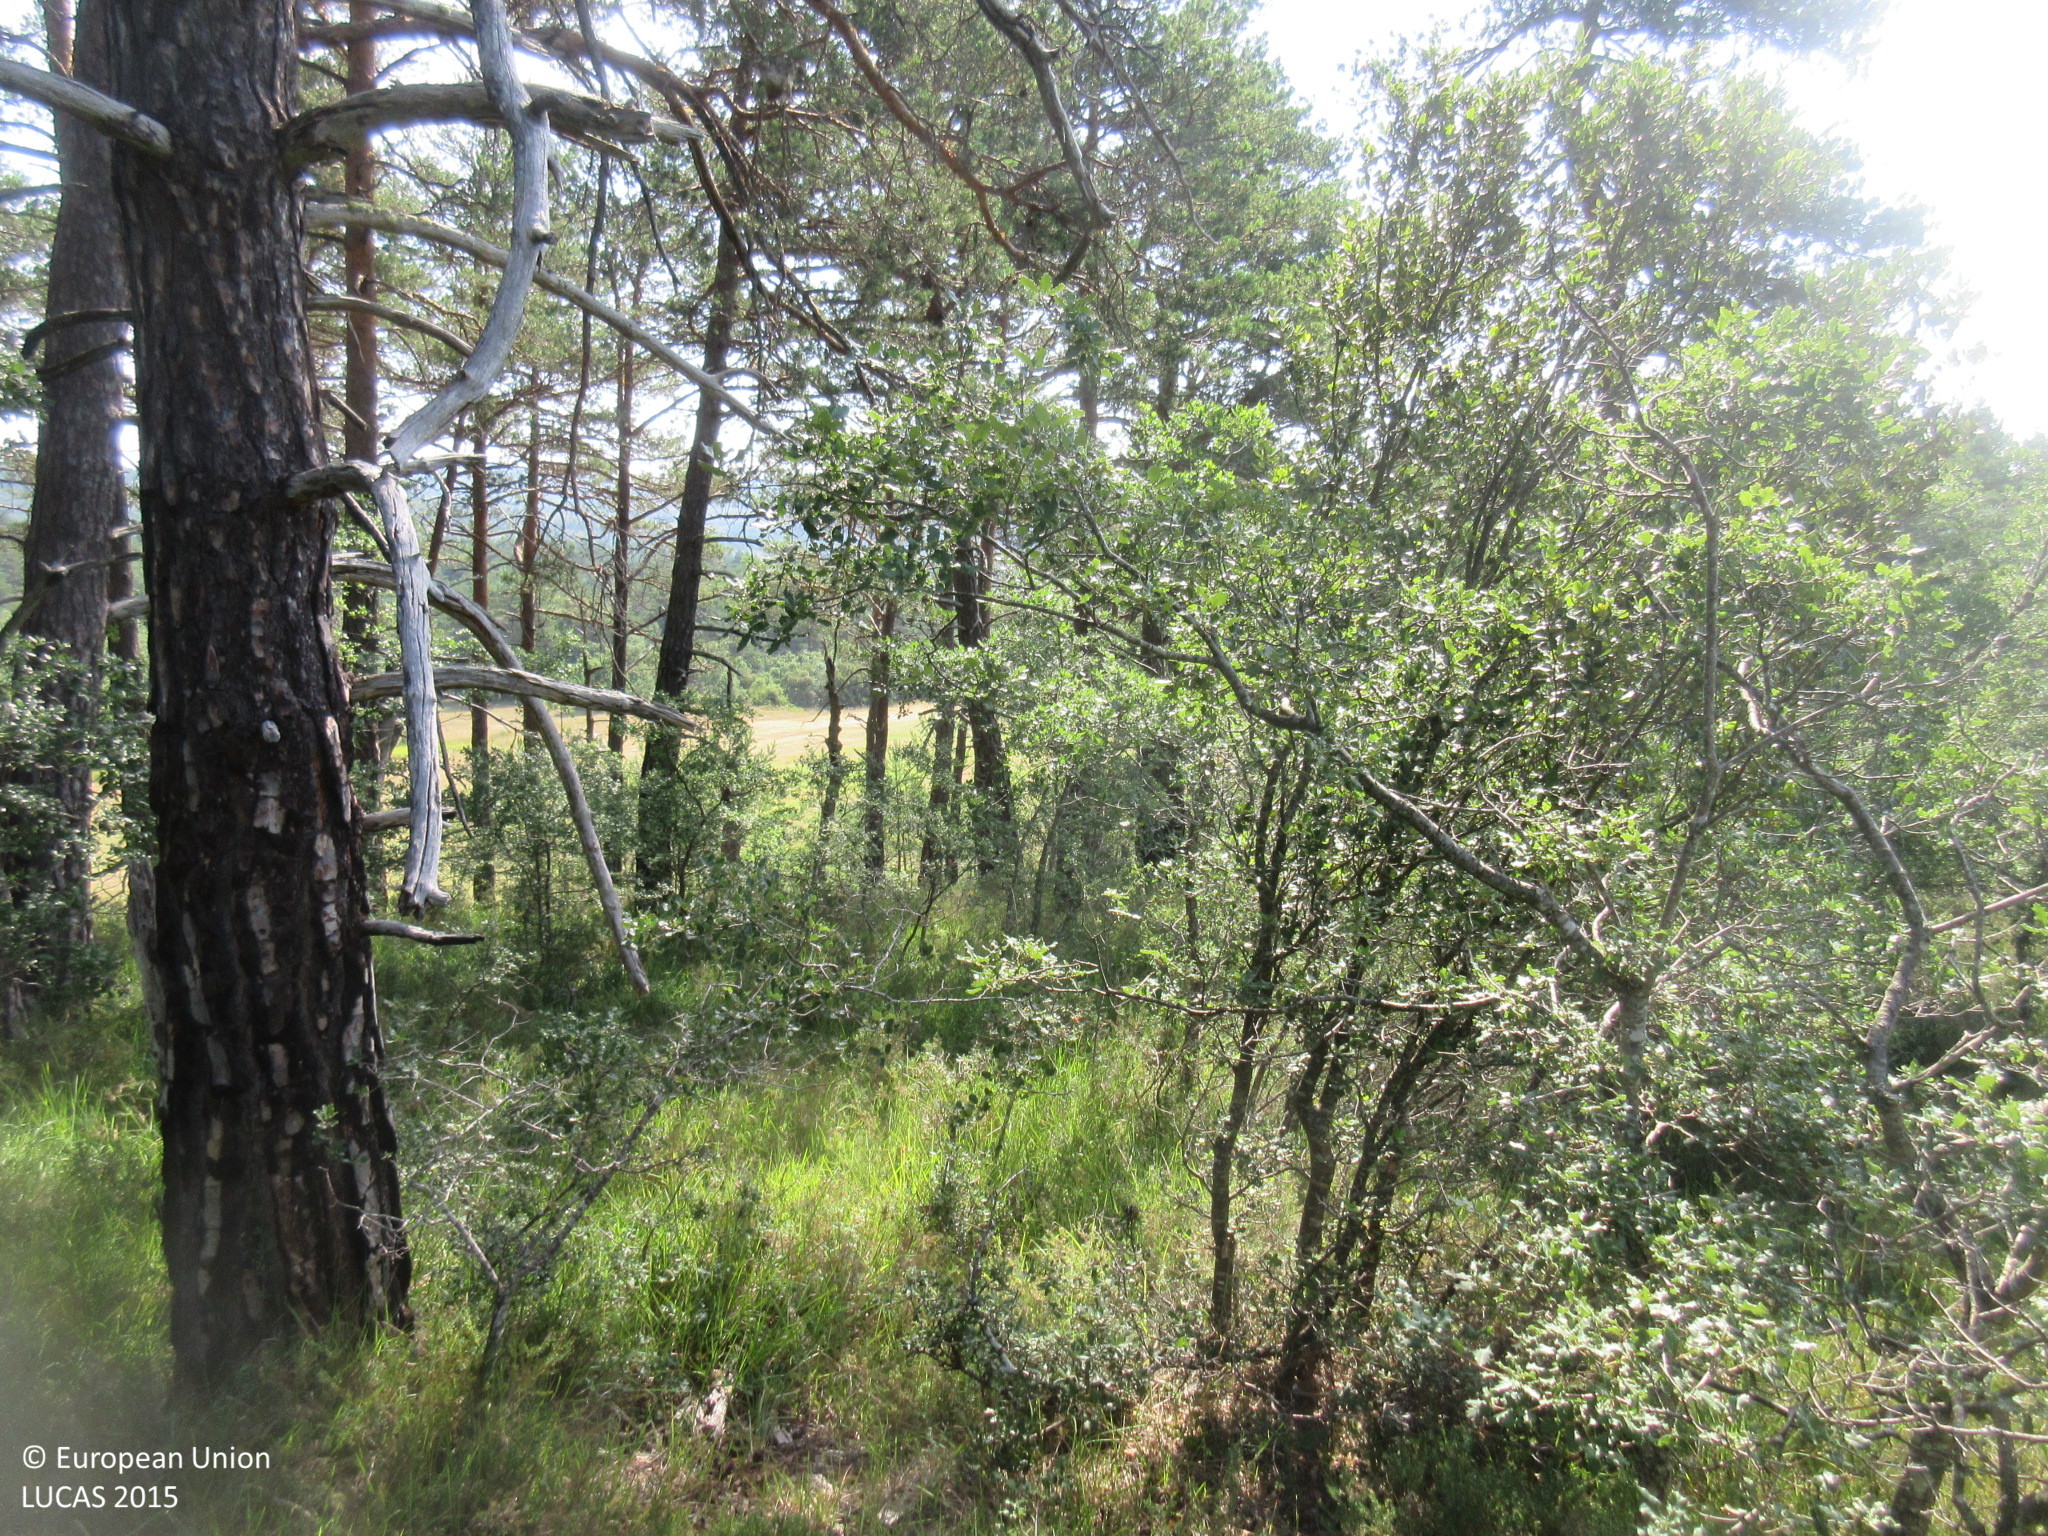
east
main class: Woodland
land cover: Broadleaved woodland
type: broadleaved evergreen forest
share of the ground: > 75 %
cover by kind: broadleaved forest trees 80 %, shrubs 20 %
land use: Forestry
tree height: > 5 m
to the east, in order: Broadleaved woodland; Pine dominated coniferous woodland; Grassland without tree/shrub cover
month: July
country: ES
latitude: 42.9910
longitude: -3.3449
